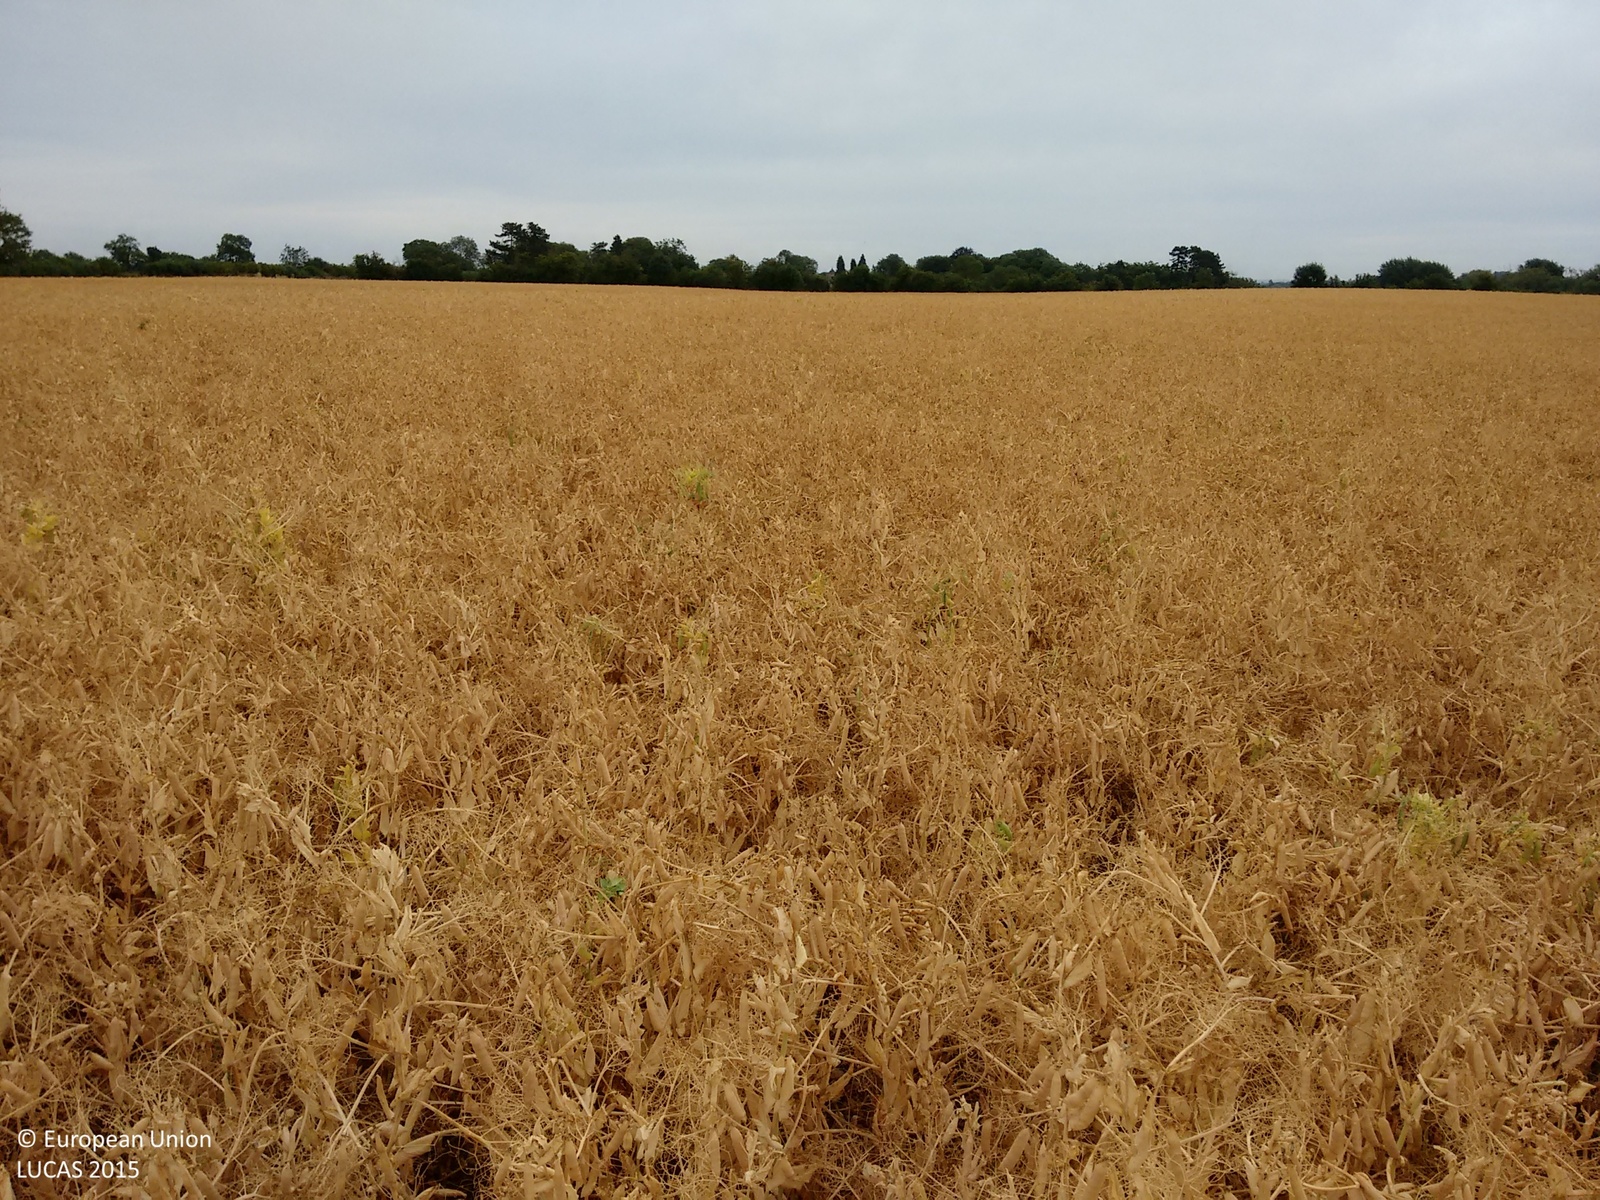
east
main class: Cropland
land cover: Dry pulses
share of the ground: > 75 %
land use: Agriculture (excluding fallow land and kitchen gardens)
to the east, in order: Dry pulses; Managed hedges; Rape and turnip rape
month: August
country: GB
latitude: 52.0275
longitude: -1.1967
